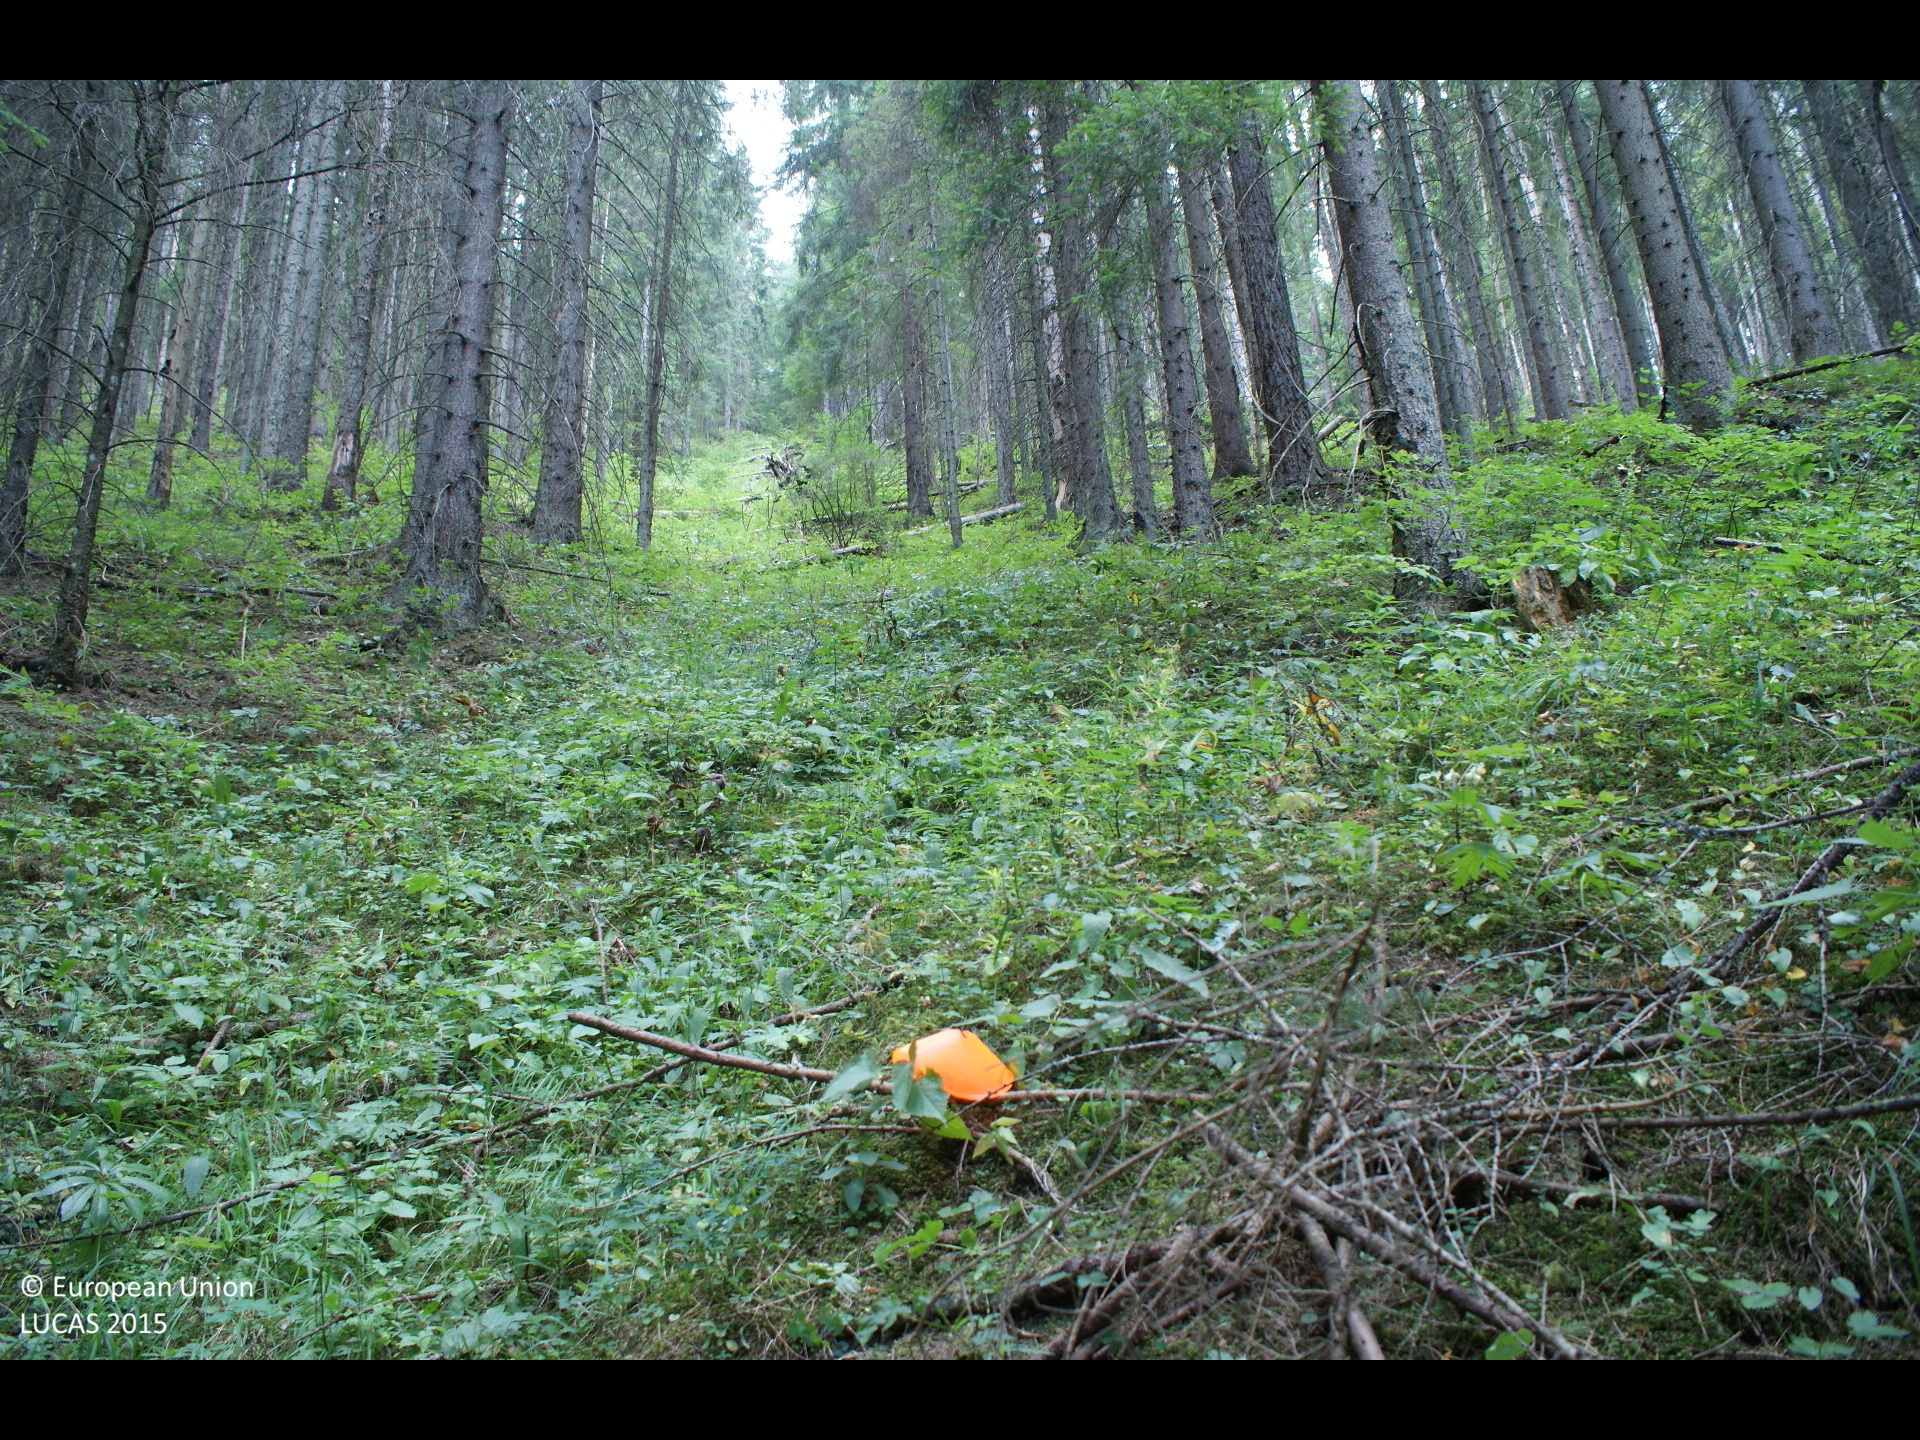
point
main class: Woodland
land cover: Spruce dominated coniferous woodland
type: alpine coniferous forest
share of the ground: > 75 %
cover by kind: coniferous forest trees 80 %, herbaceous plants 10 %, lichens and mosses 10 %
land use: Forestry
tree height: > 5 m
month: August
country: AT
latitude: 47.7344
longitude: 15.3215
